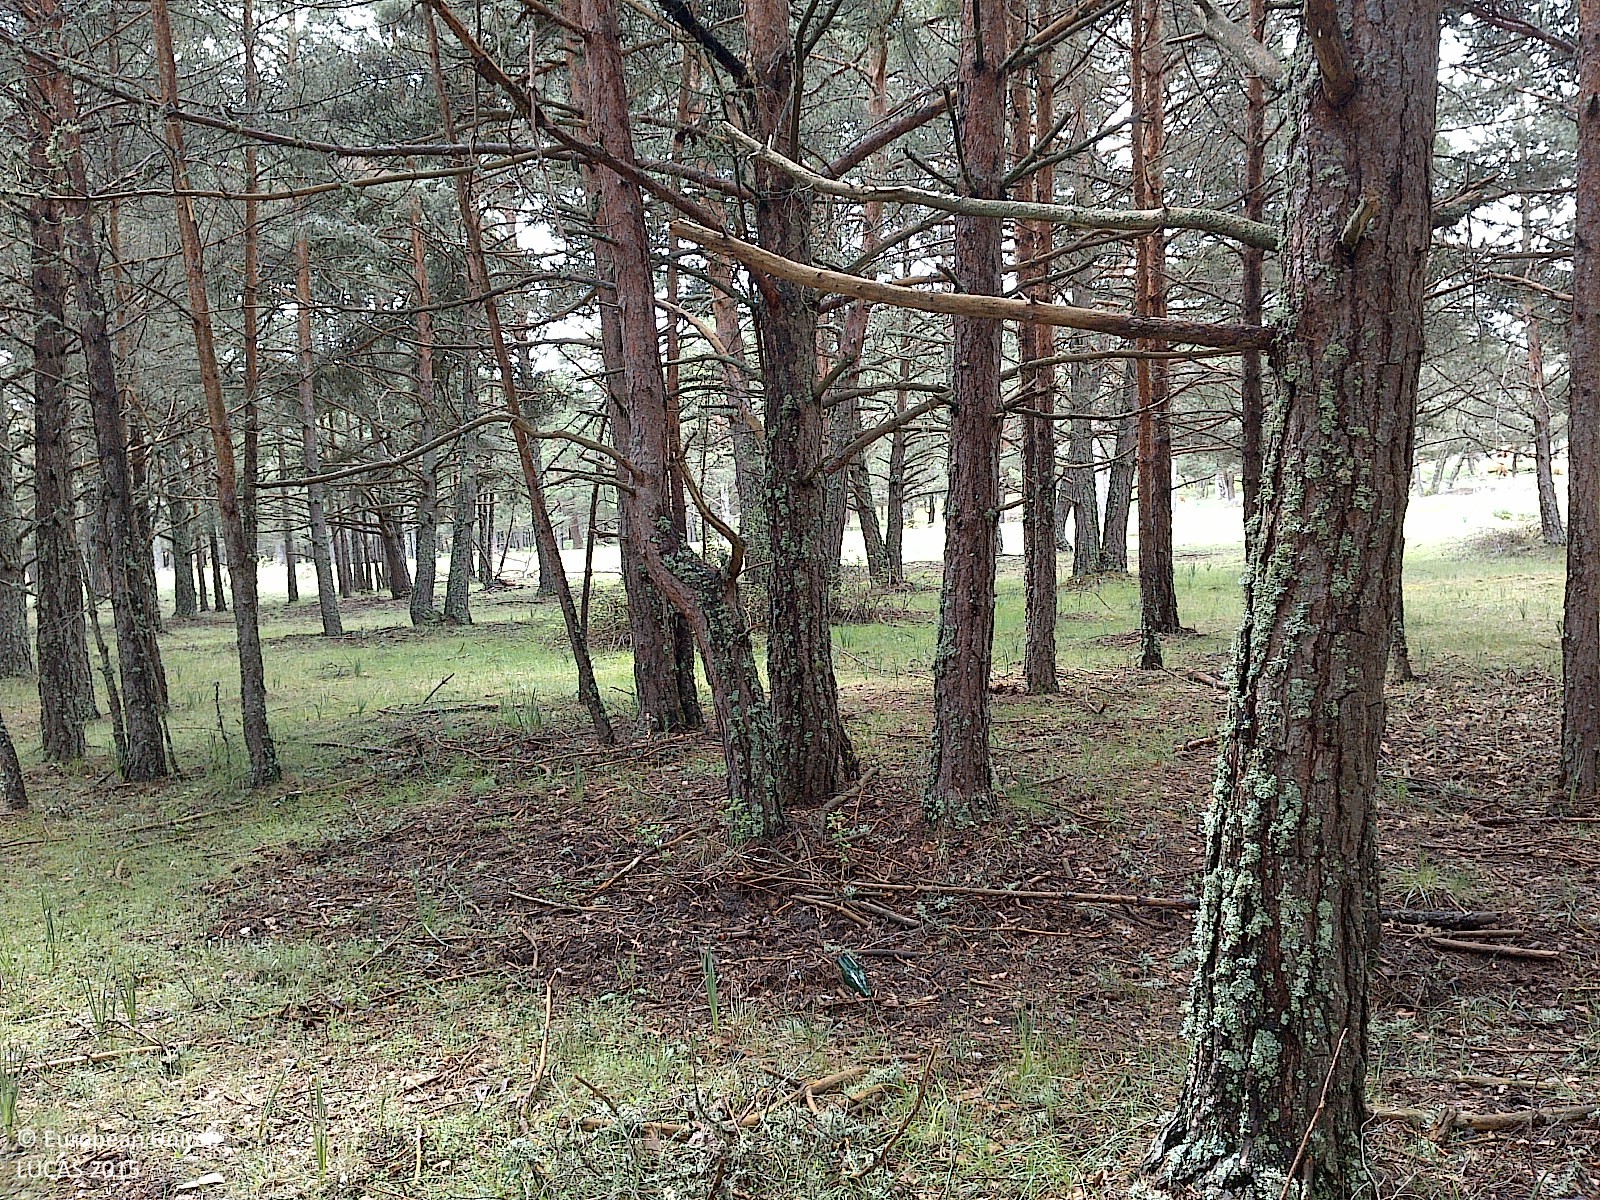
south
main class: Woodland
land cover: Pine dominated coniferous woodland
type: coniferous forest of the mediterranean region
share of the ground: > 75 %
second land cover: Grassland without tree/shrub cover
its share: 50 - 75 %
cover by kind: coniferous forest trees 85 %, herbaceous plants 15 %
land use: Forestry
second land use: Agriculture (excluding fallow land and kitchen gardens)
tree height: > 5 m
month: April
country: ES
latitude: 41.8180
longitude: -2.8156
